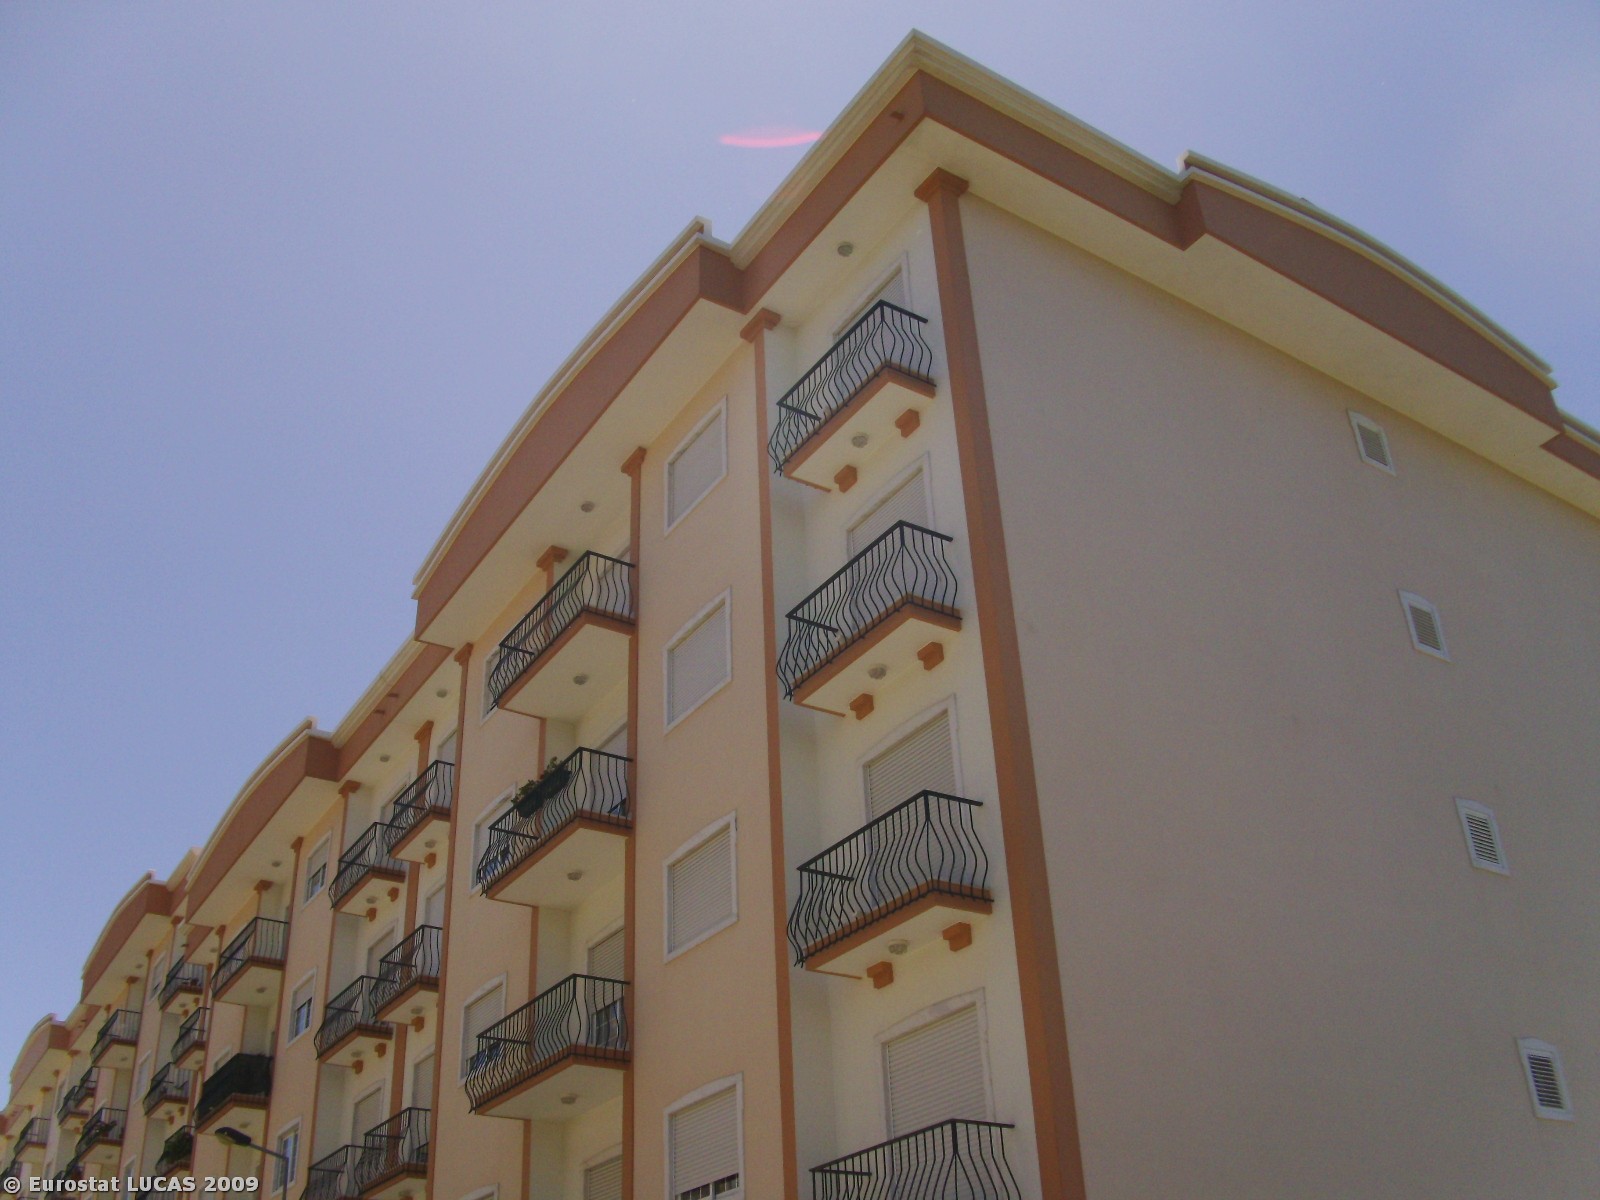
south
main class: Woodland
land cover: Coniferous woodland
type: coniferous forest of the mediterranean region
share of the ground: 25 - 50 %
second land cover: Shrubland with sparse tree cover
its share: 50 - 75 %
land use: Forestry
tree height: > 5 m
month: July
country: PT
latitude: 38.6247
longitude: -9.1285
